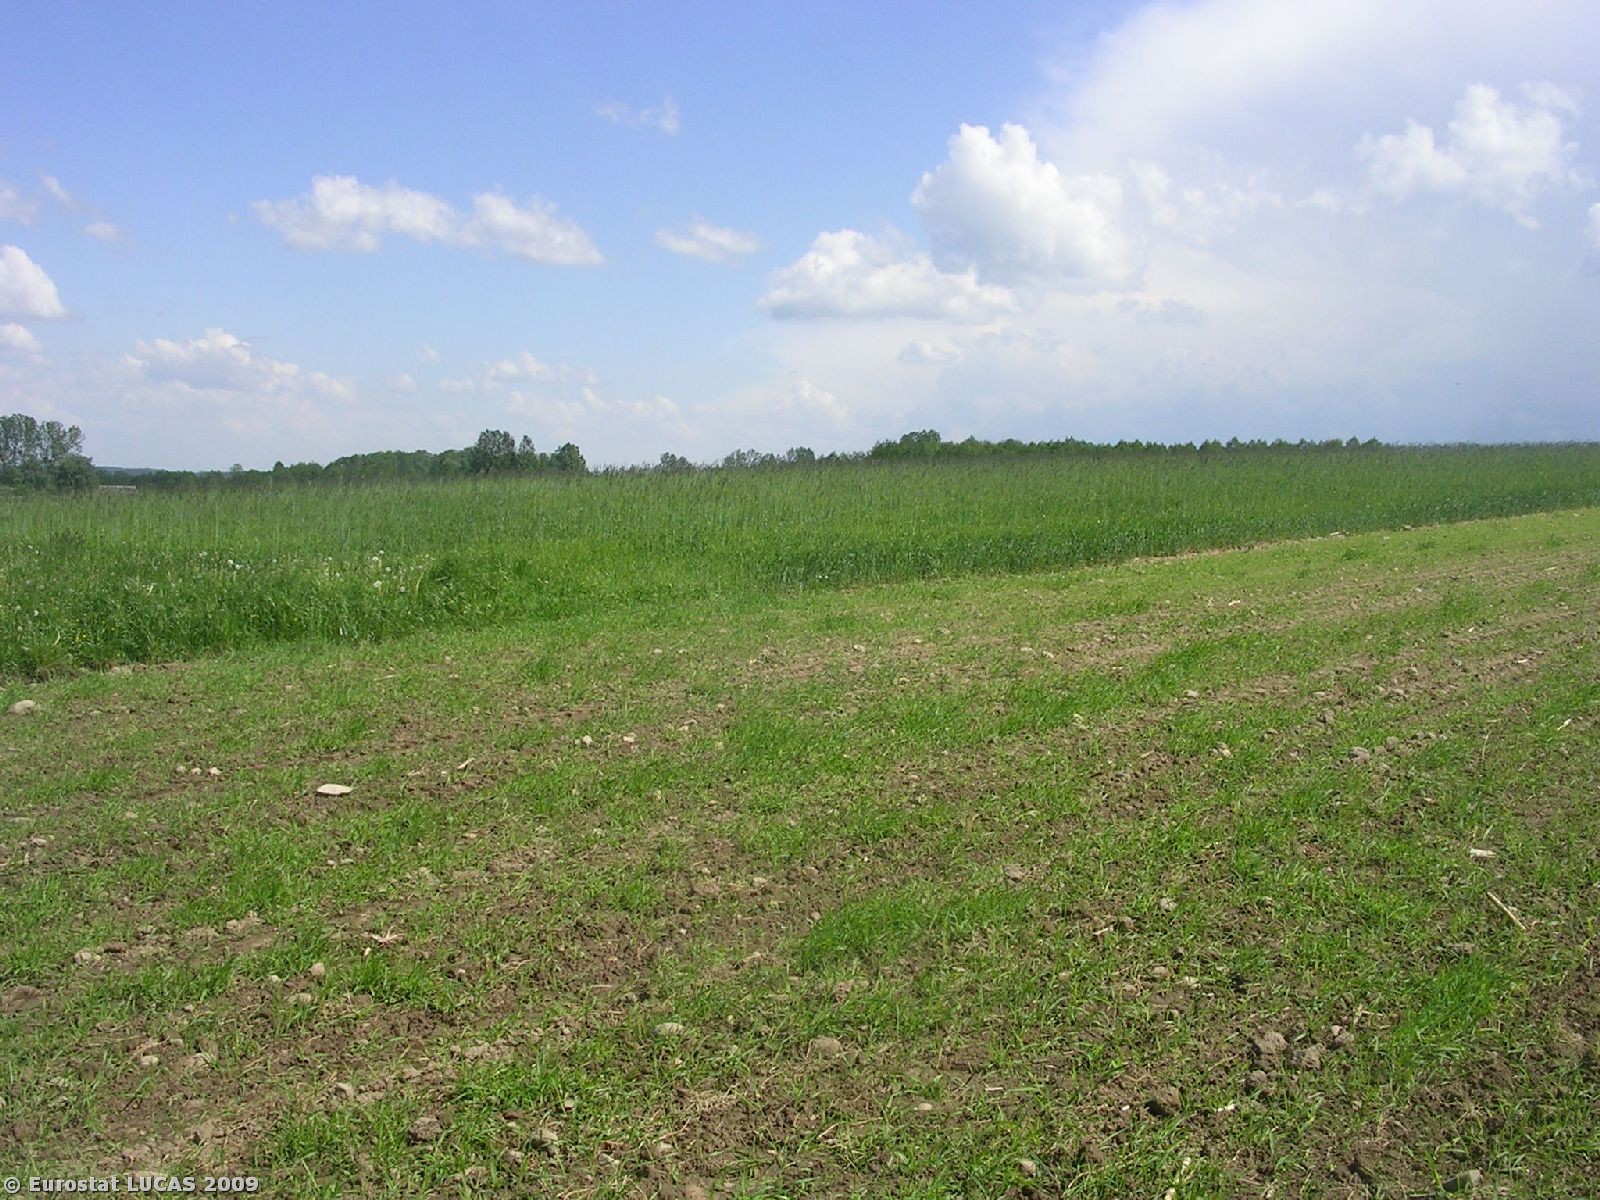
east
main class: Cropland
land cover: Maize
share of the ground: 10 - 25 %
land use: Agriculture (excluding fallow land and kitchen gardens)
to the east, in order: Maize; Grassland without tree/shrub cover; Artificial constructions in urban areas; Rye; Paved roads, cycling and walking lanes; Fences; Grassland without tree/shrub cover; Fences; Oats; Grass margins; Grassland without tree/shrub cover
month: May
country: PL
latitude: 53.5665
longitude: 23.3836
